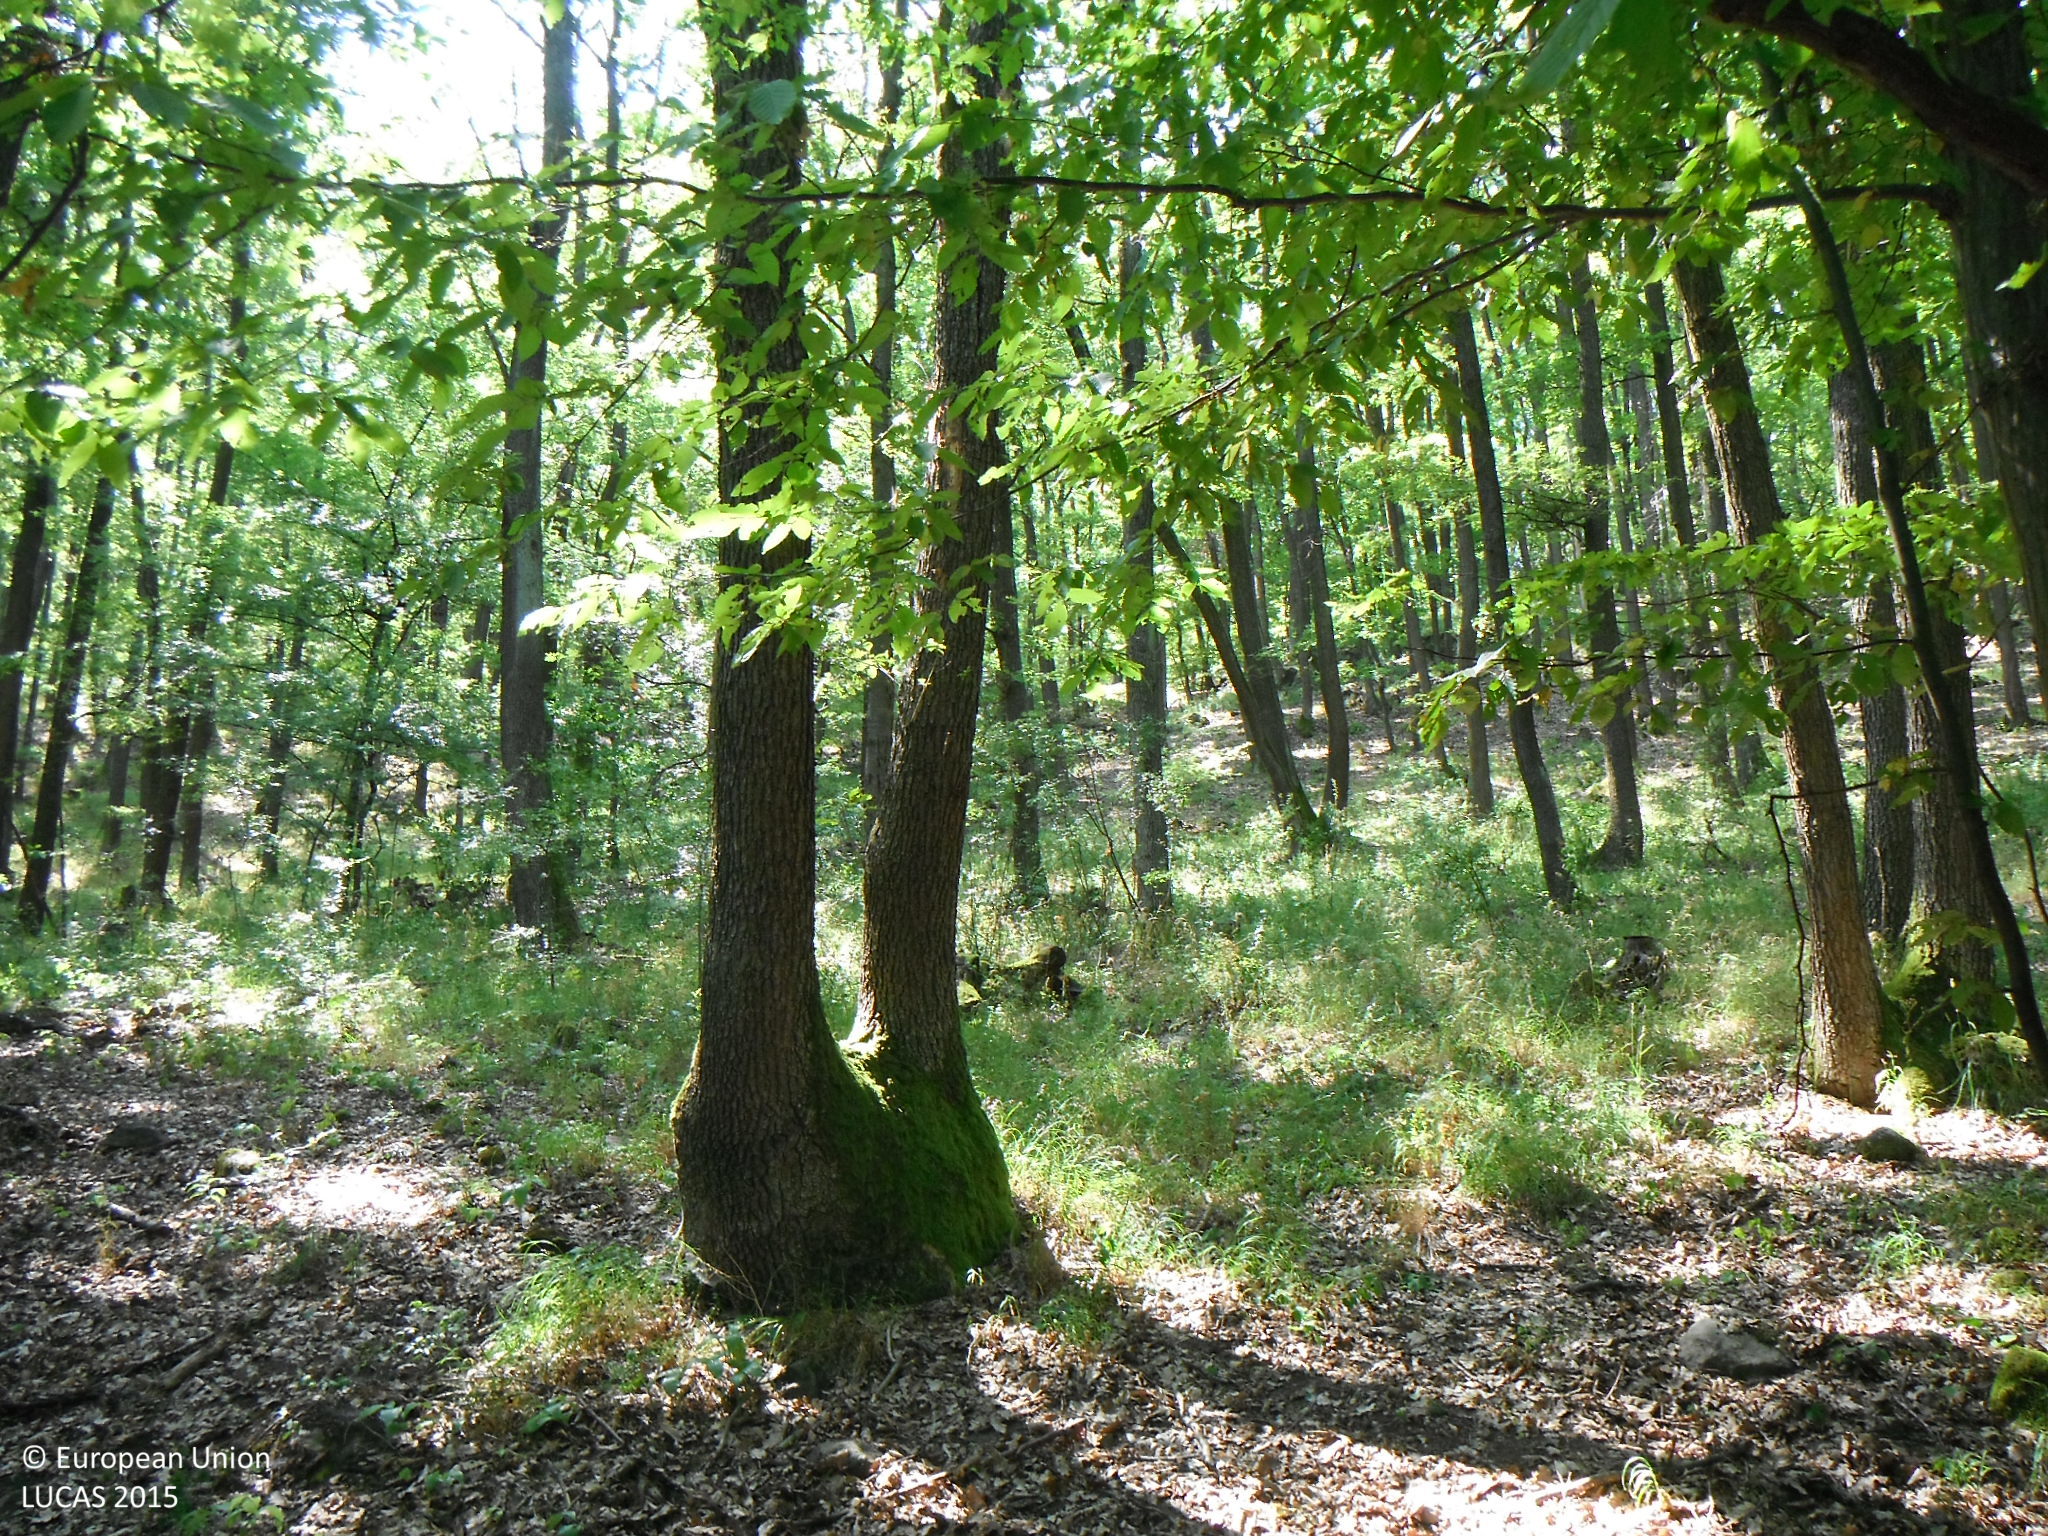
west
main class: Woodland
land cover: Broadleaved woodland
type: acidophilous oak and oak-birch forest
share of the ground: > 75 %
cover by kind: broadleaved forest trees 100 %
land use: Forestry
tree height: > 5 m
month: July
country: SK
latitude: 48.1370
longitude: 19.0910
